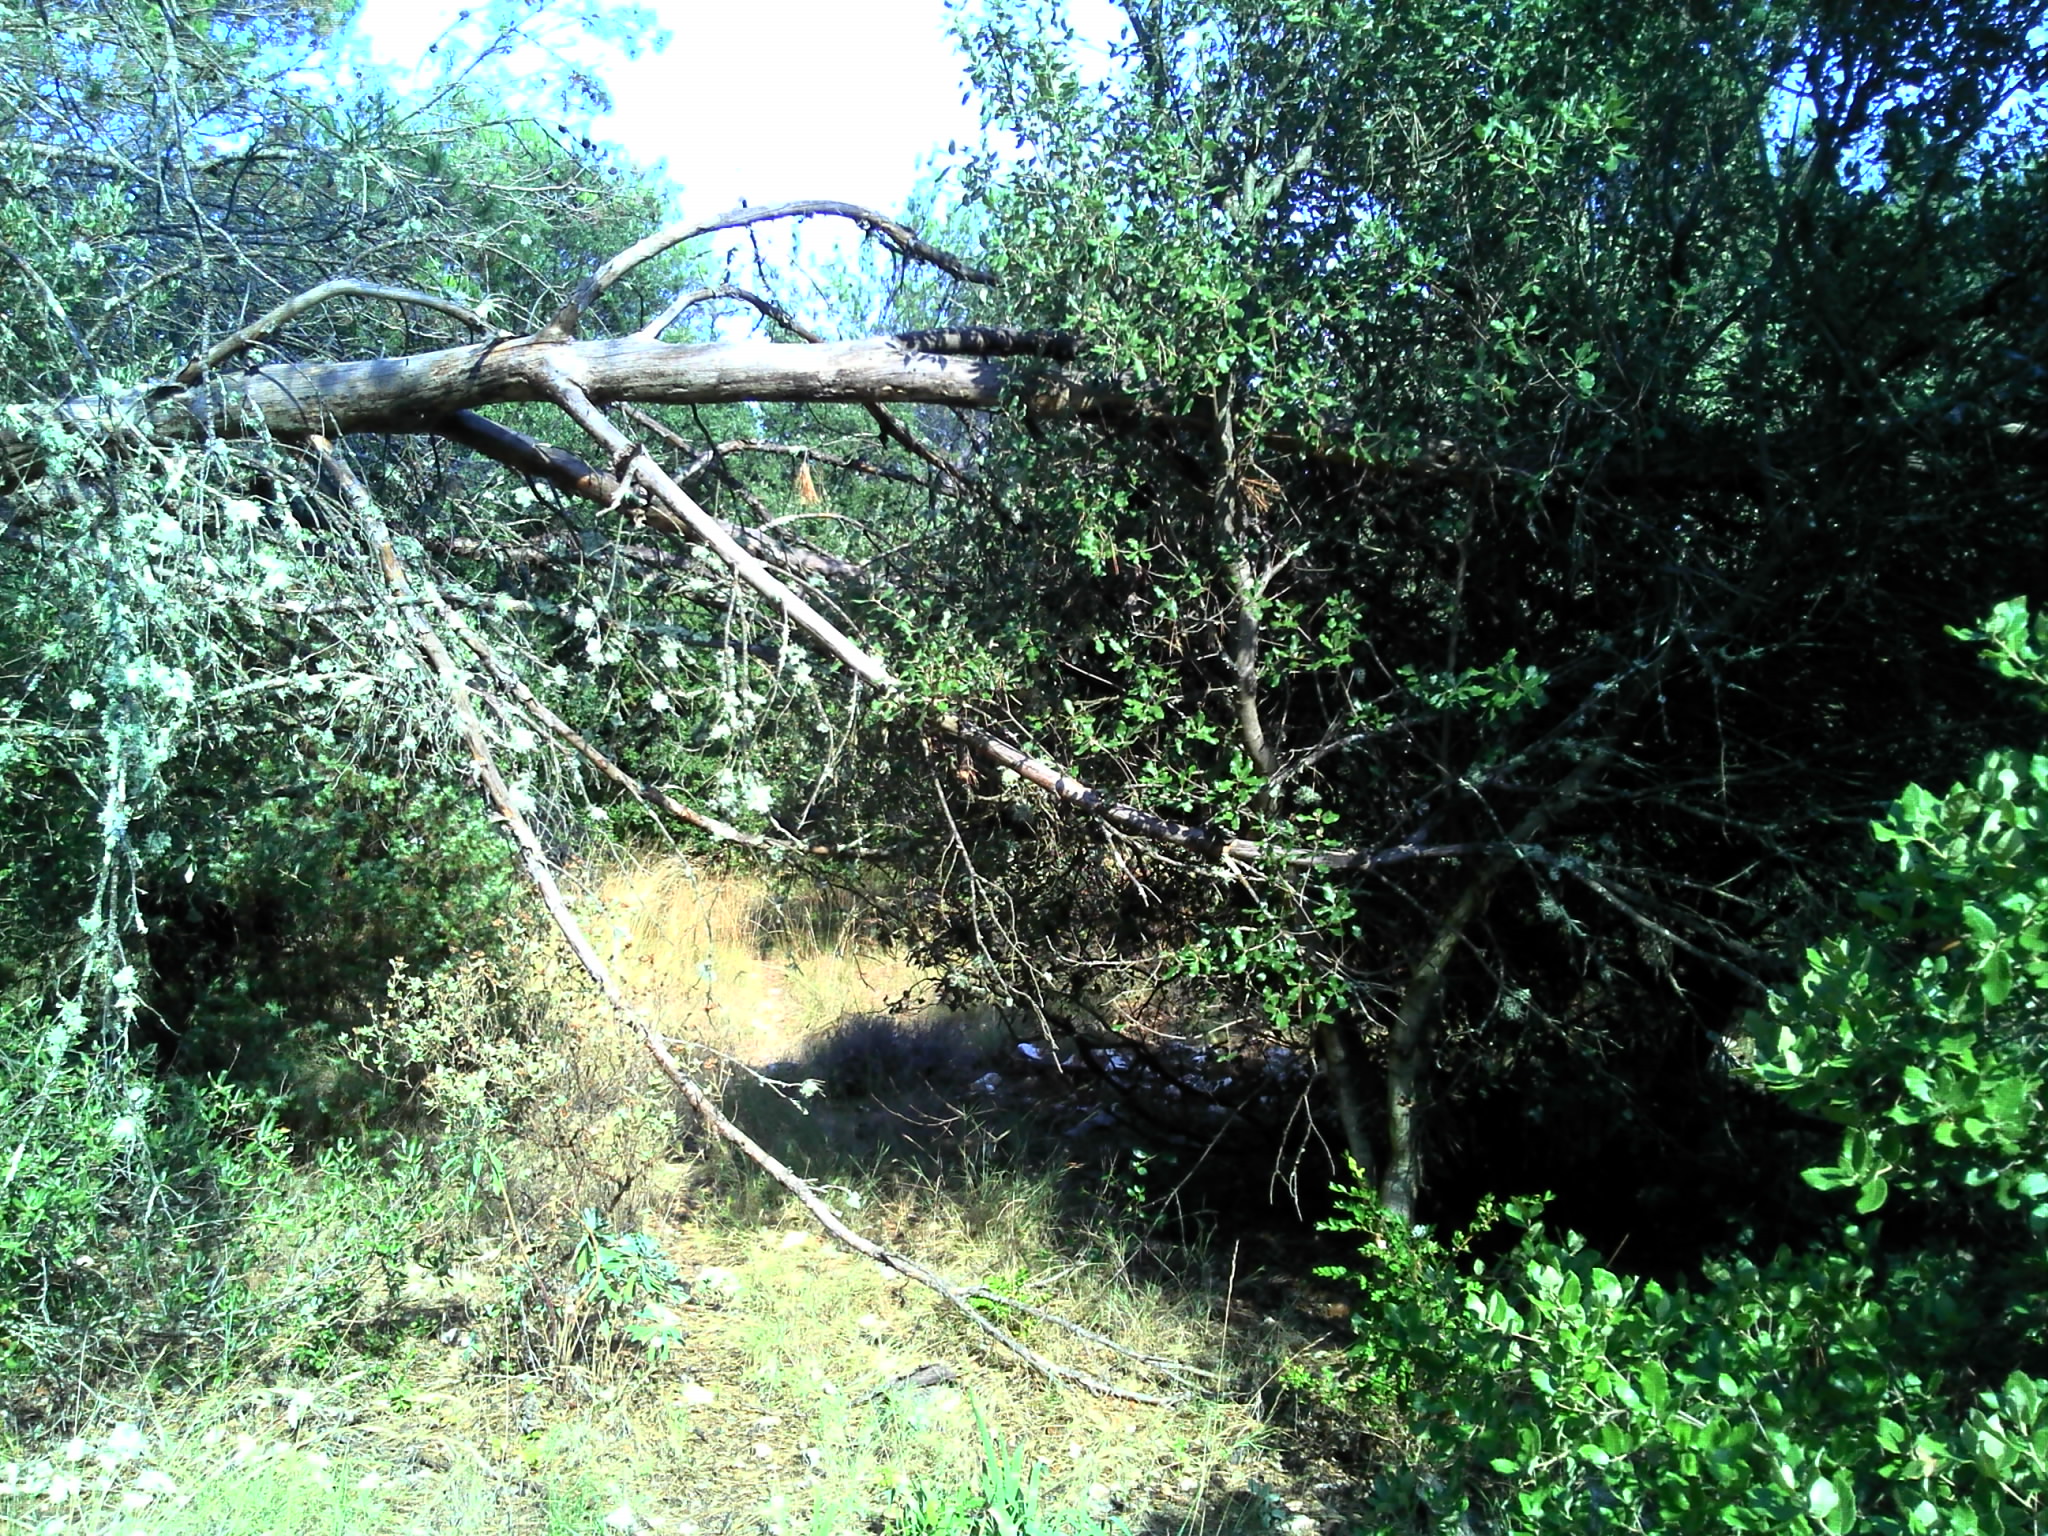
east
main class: Woodland
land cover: Pine dominated mixed woodland
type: coniferous forest of the mediterranean region
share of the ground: > 75 %
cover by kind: broadleaved forest trees 40 %, coniferous forest trees 30 %, herbaceous plants 20 %, shrubs 5 %, consolidated bare surface 5 %
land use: Semi-natural and natural areas not in use
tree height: > 5 m
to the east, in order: Pine dominated mixed woodland; Tracks; Pine dominated mixed woodland; Broadleaved woodland; Tracks; Broadleaved woodland; Other bare soil; Fences; Other bare soil; Broadleaved woodland
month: August
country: FR
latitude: 44.0308
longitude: 4.6305
